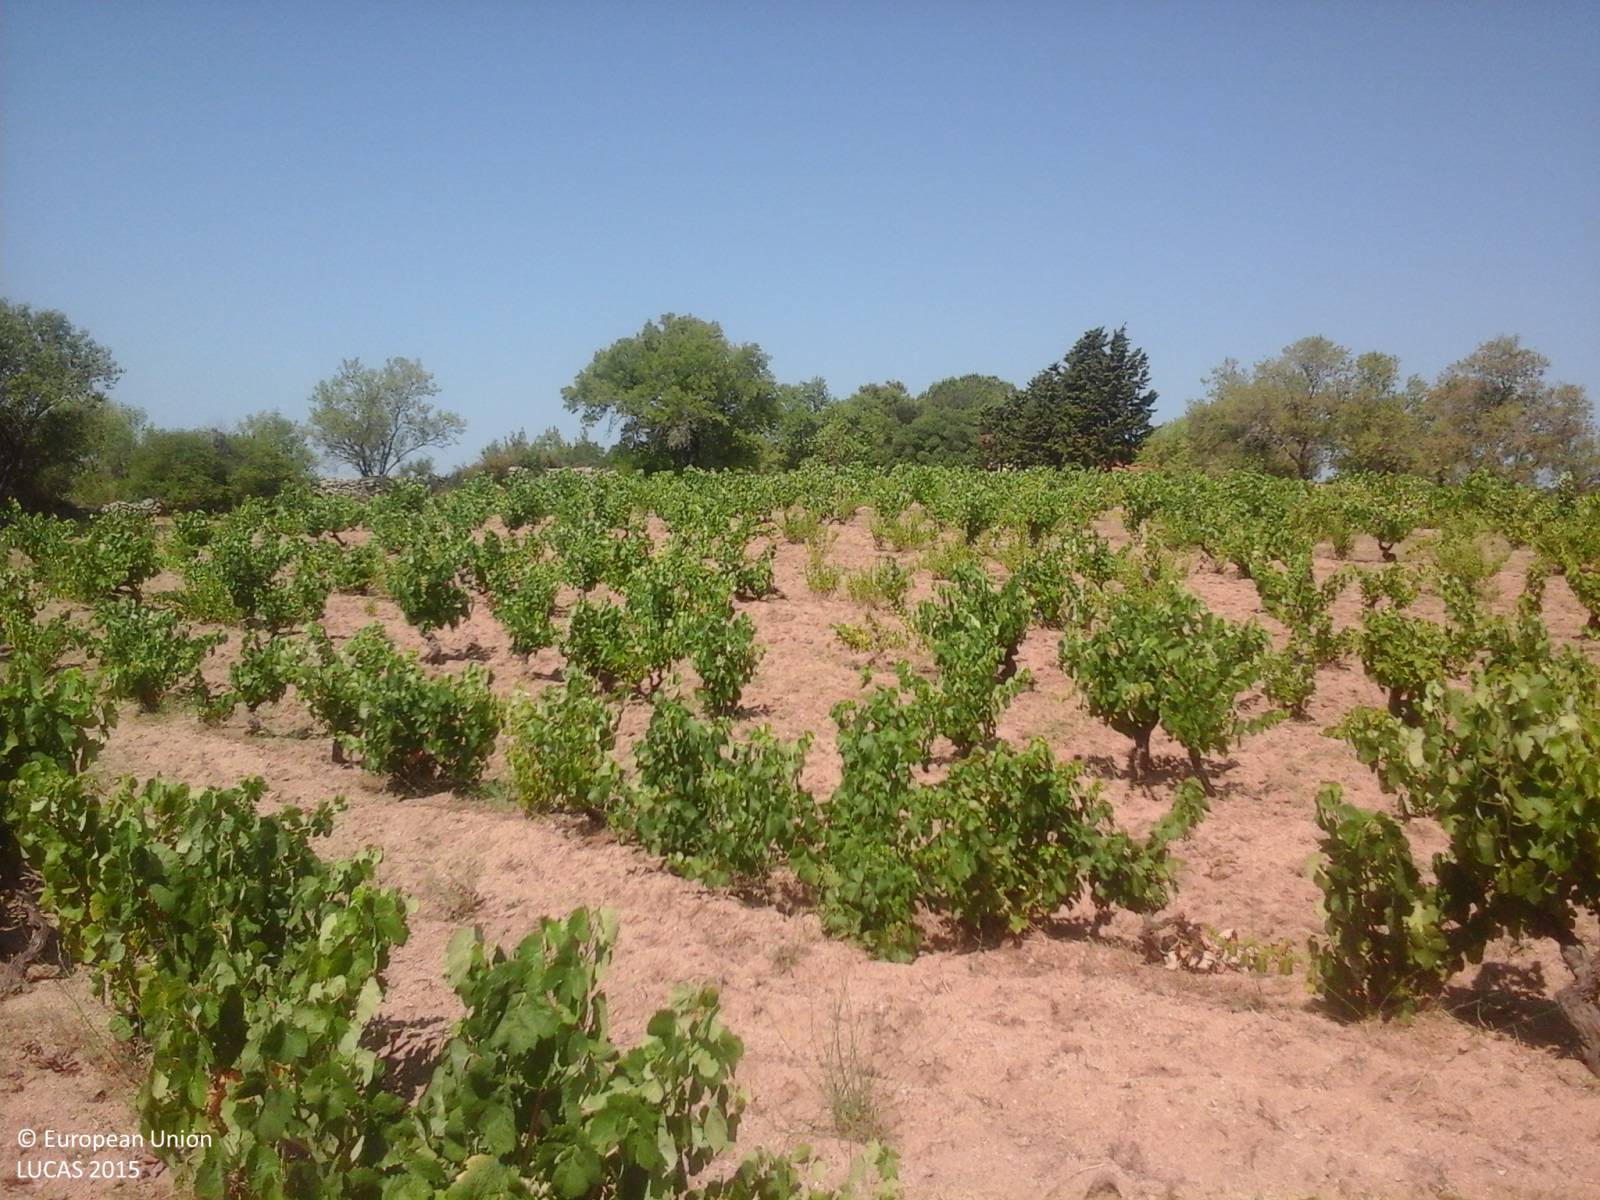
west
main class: Cropland
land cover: Vineyards
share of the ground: > 75 %
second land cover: Other bare soil
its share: > 75 %
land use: Agriculture (excluding fallow land and kitchen gardens)
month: July
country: IT
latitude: 40.8446
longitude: 9.3980
